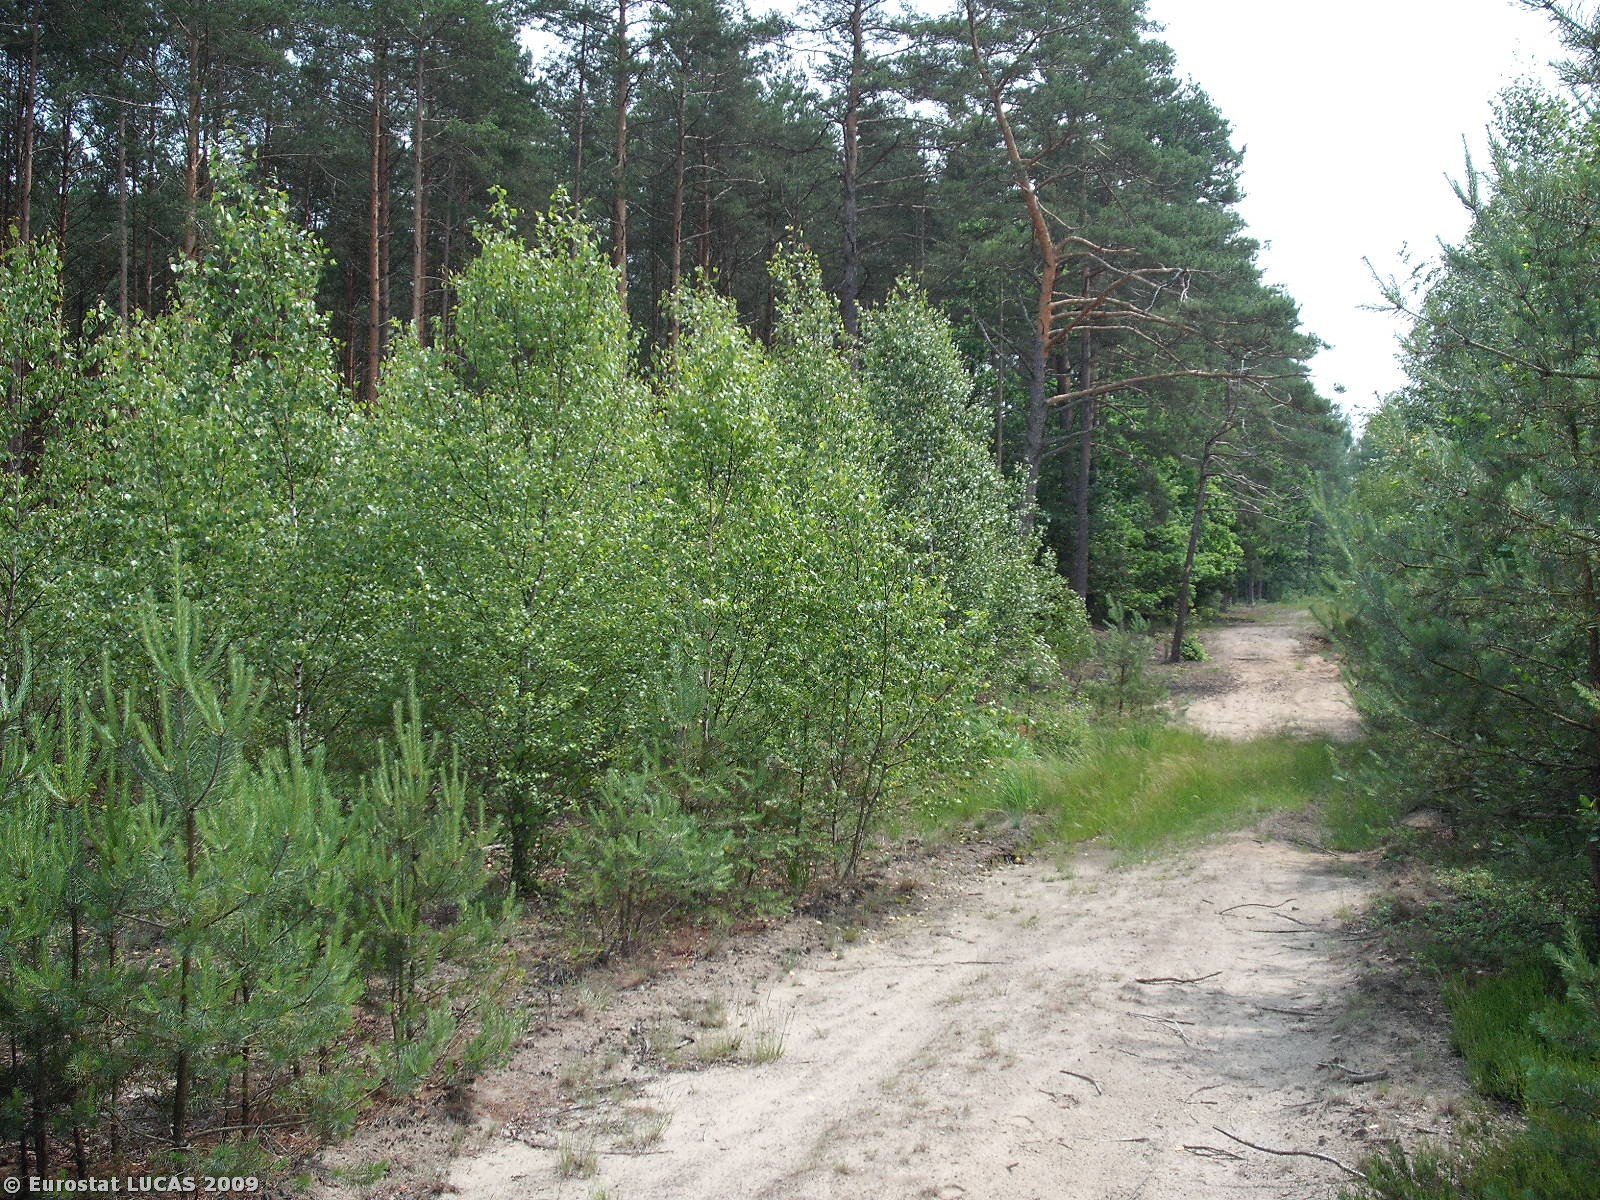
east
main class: Woodland
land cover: Coniferous woodland
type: hemiboreal forest and nemoral coniferous forest and mixed broadleaved-coniferous forest
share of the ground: > 75 %
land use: Forestry
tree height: > 5 m
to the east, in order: Coniferous woodland; Tracks; Coniferous woodland; Tracks; Coniferous woodland; Mixed woodland
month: June
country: PL
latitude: 51.2057
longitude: 20.4724
